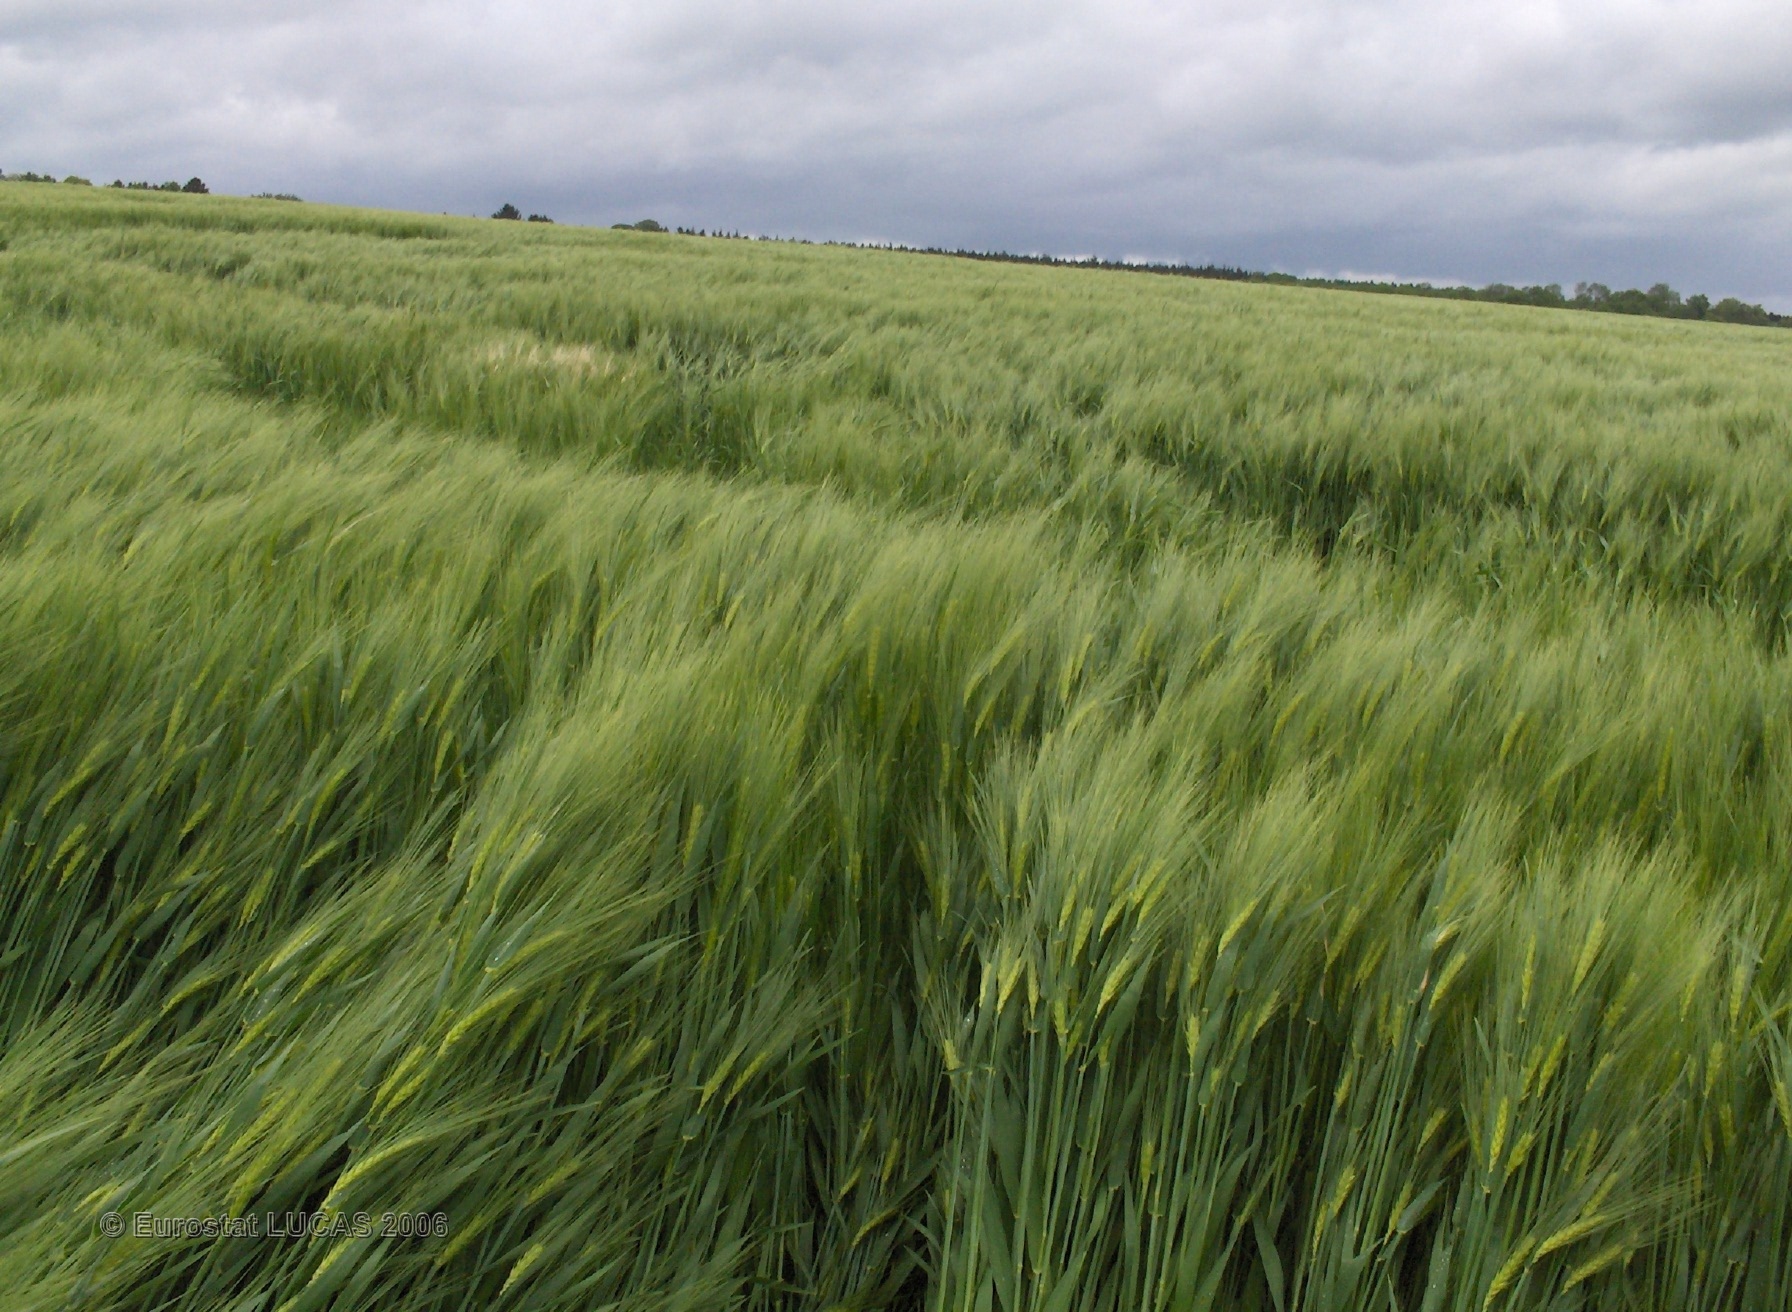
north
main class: Cropland
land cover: Barley
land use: Agriculture (excluding fallow land and kitchen gardens)
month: May
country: BE
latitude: 50.4277
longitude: 5.2539
